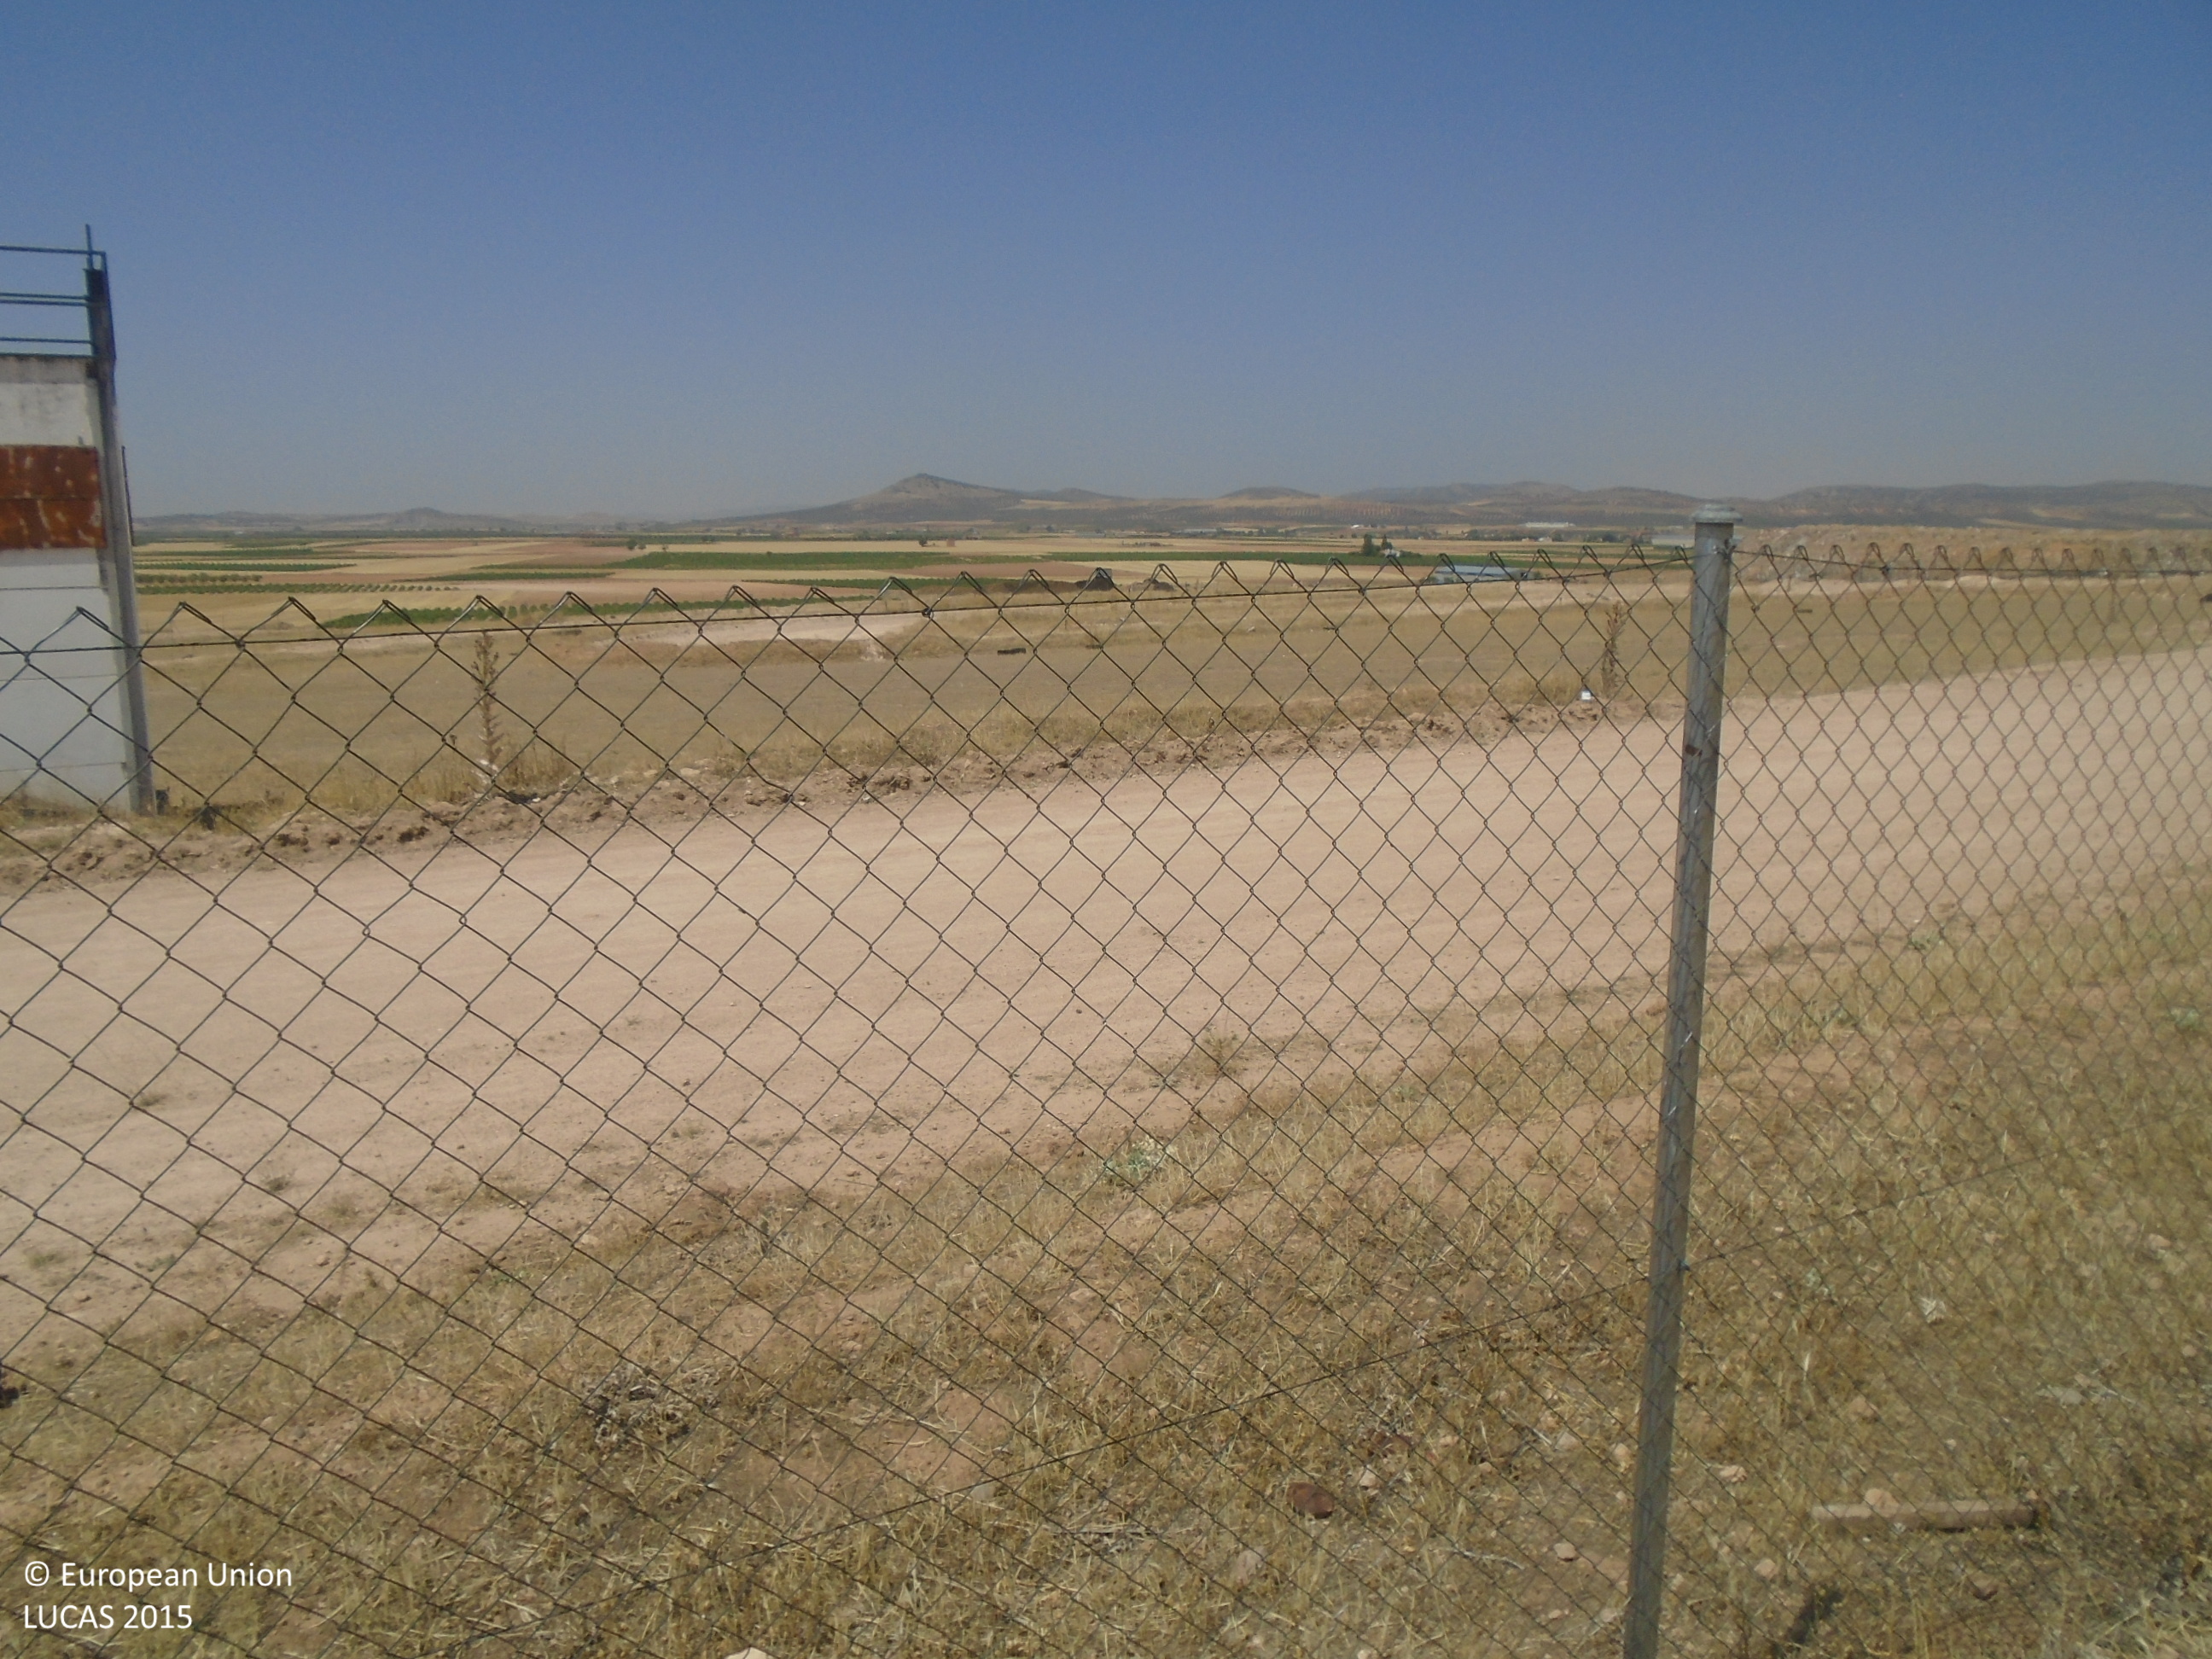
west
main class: Grassland
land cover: Grassland without tree/shrub cover
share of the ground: > 75 %
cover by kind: herbaceous plants 100 %
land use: Agriculture (excluding fallow land and kitchen gardens)
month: July
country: ES
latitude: 39.4428
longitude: -3.6063
